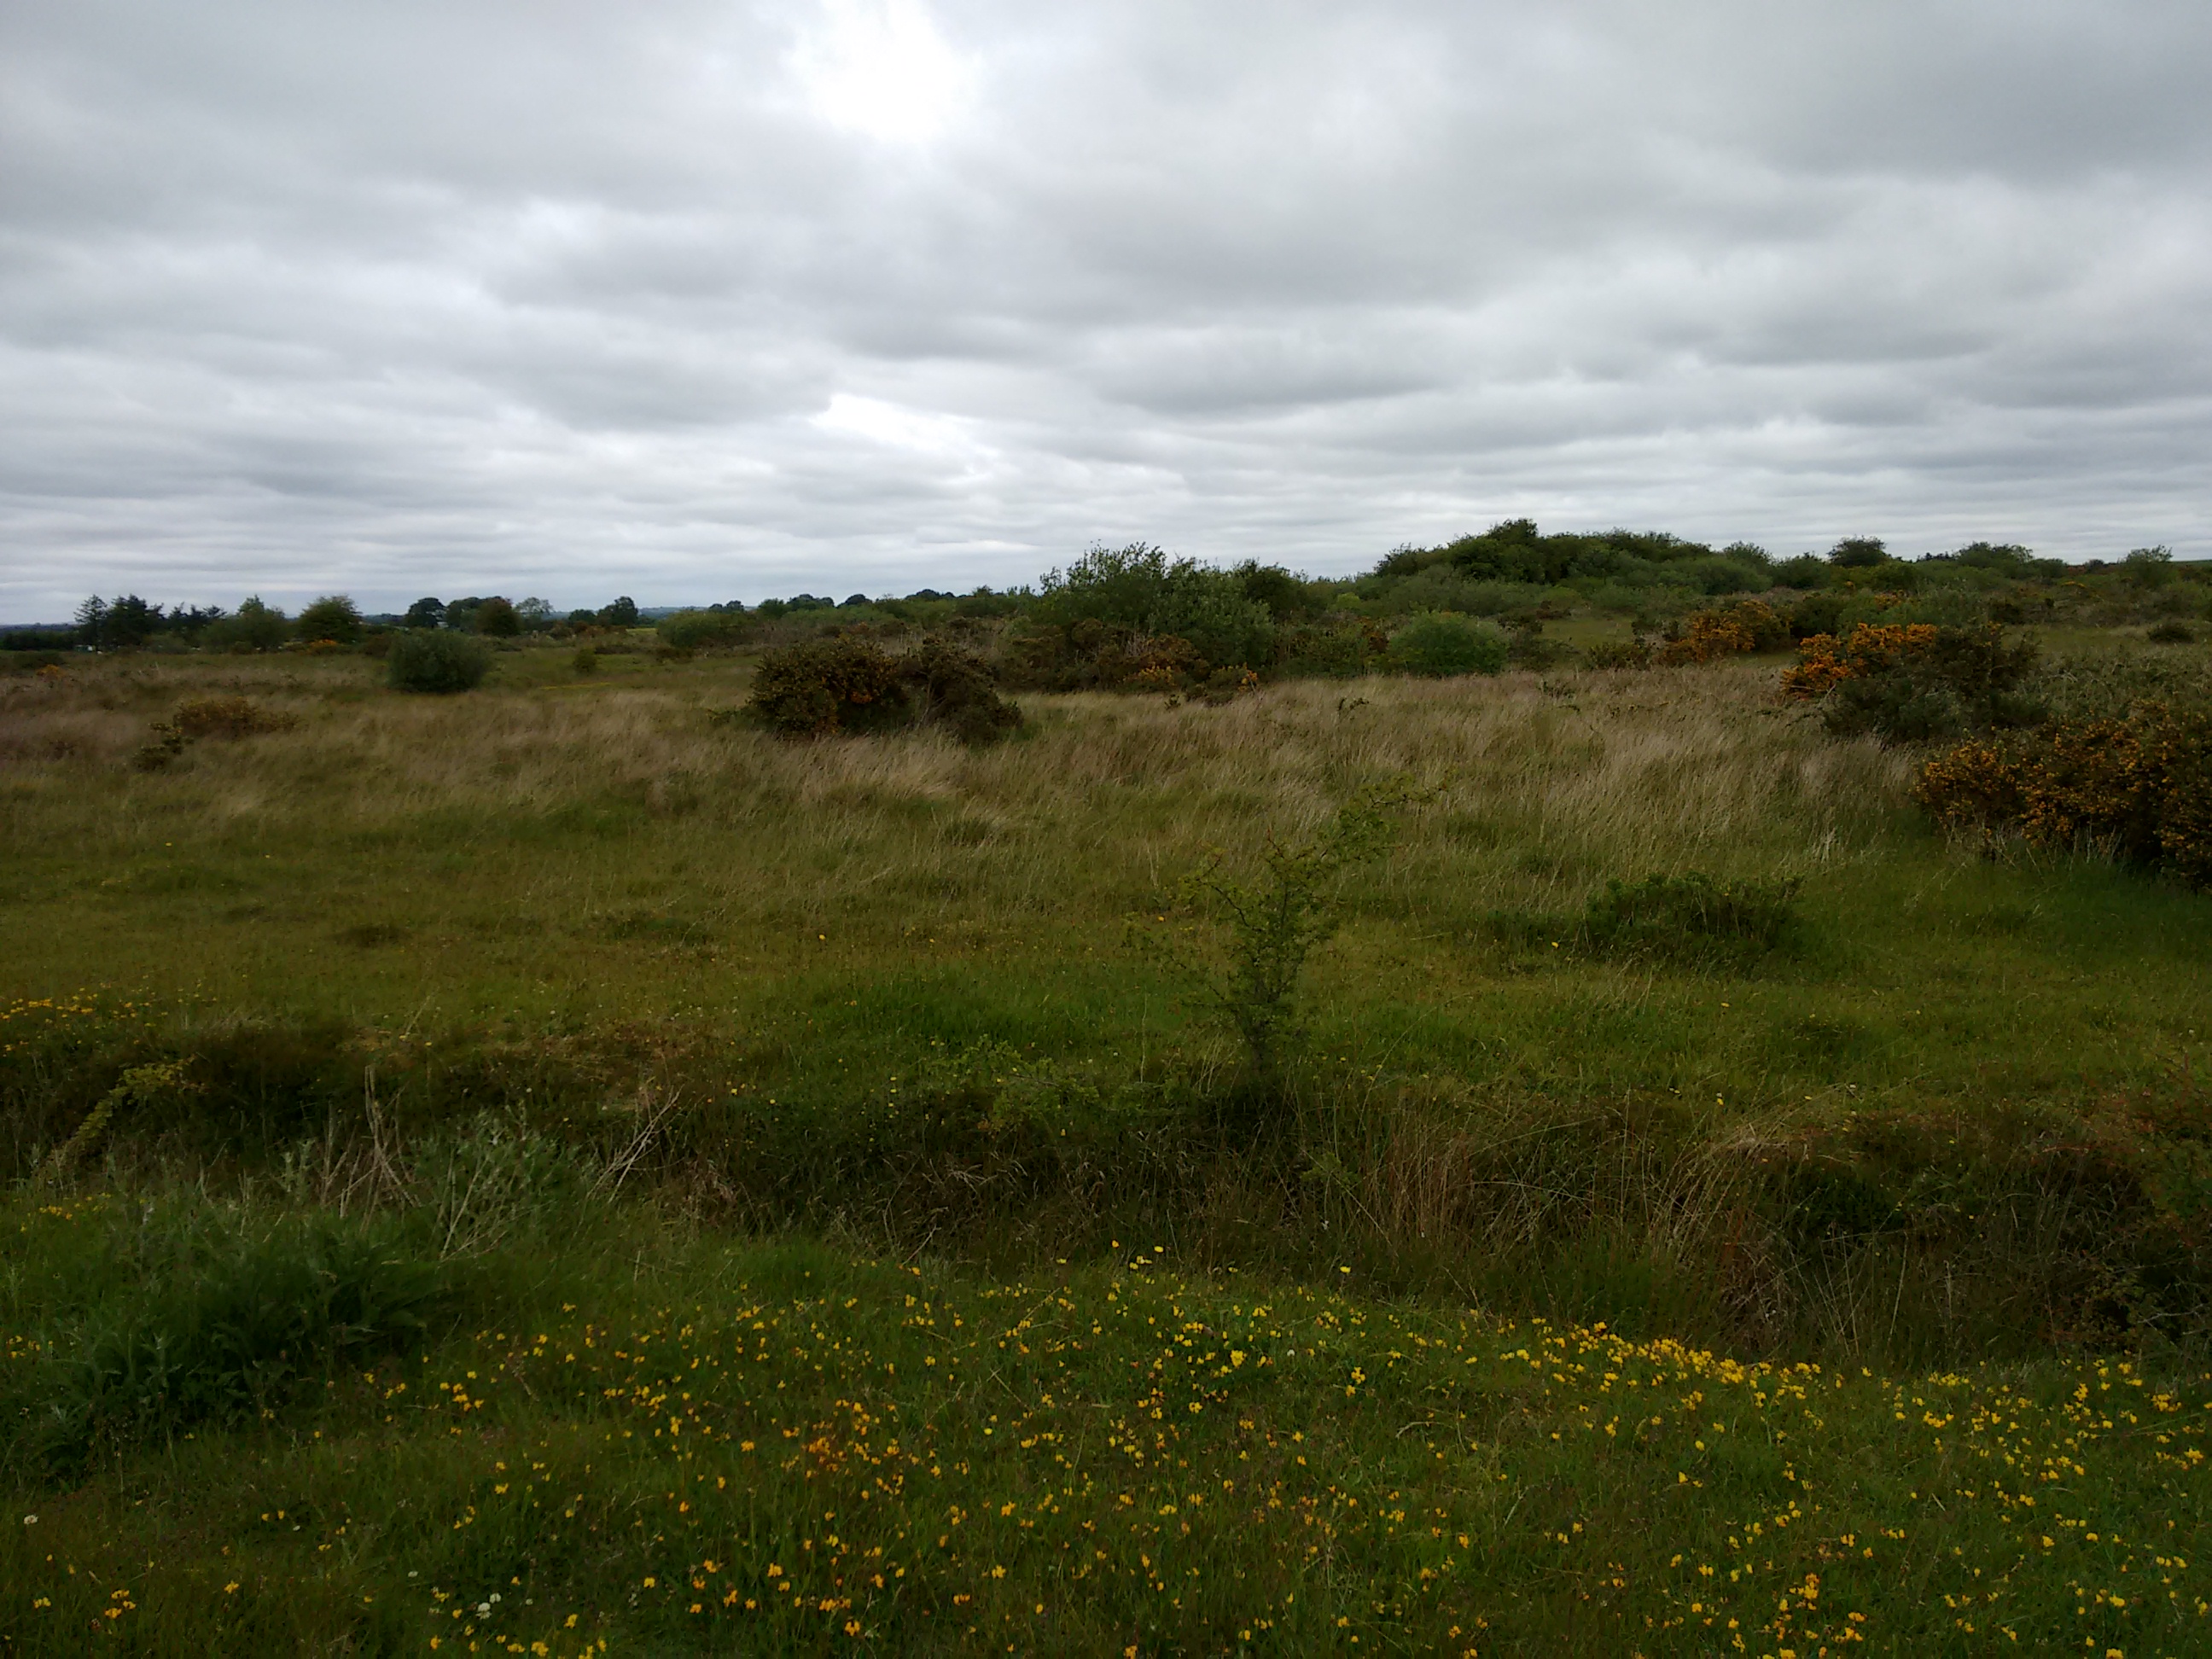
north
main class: Shrubland
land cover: Shrubland without tree cover
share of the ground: > 75 %
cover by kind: herbaceous plants 60 %, shrubs 40 %
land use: Agriculture (excluding fallow land and kitchen gardens)
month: June
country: IE
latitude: 53.5703
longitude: -8.8243
